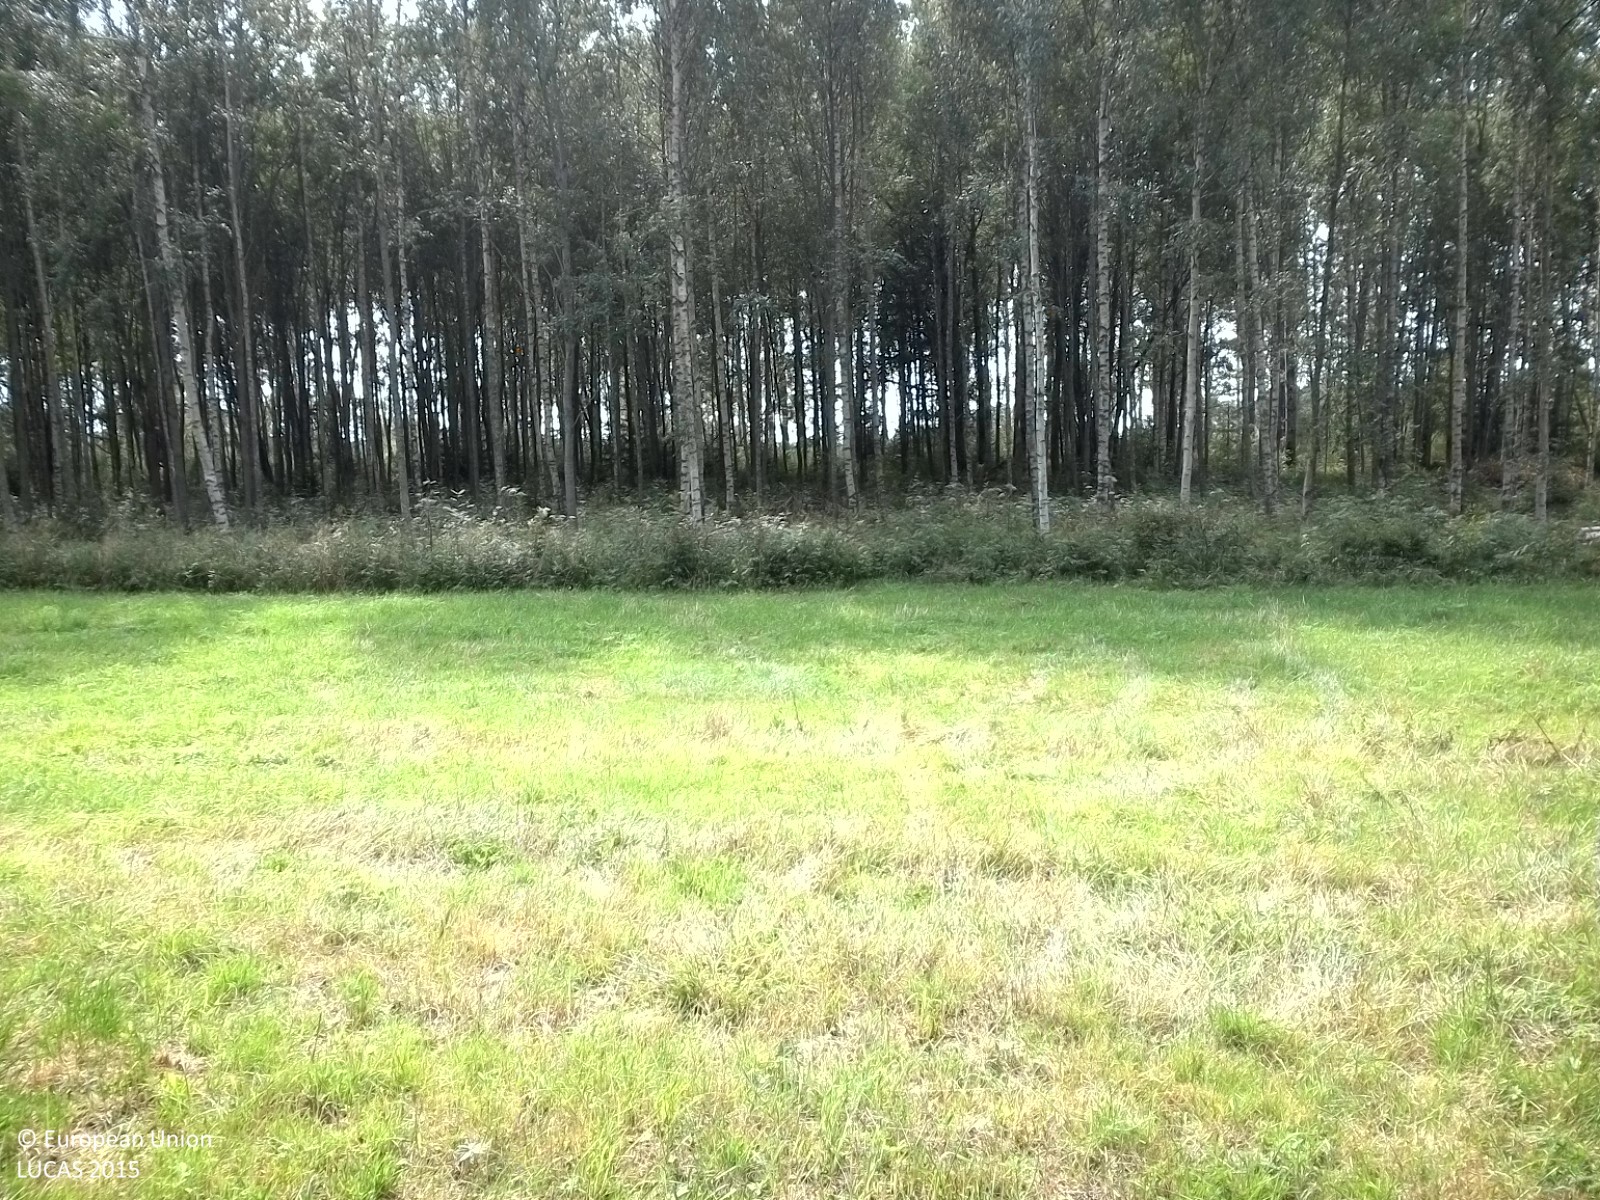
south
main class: Cropland
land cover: Temporary grasslands
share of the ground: > 75 %
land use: Agriculture (excluding fallow land and kitchen gardens)
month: August
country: SE
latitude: 59.0703
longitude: 14.8238
